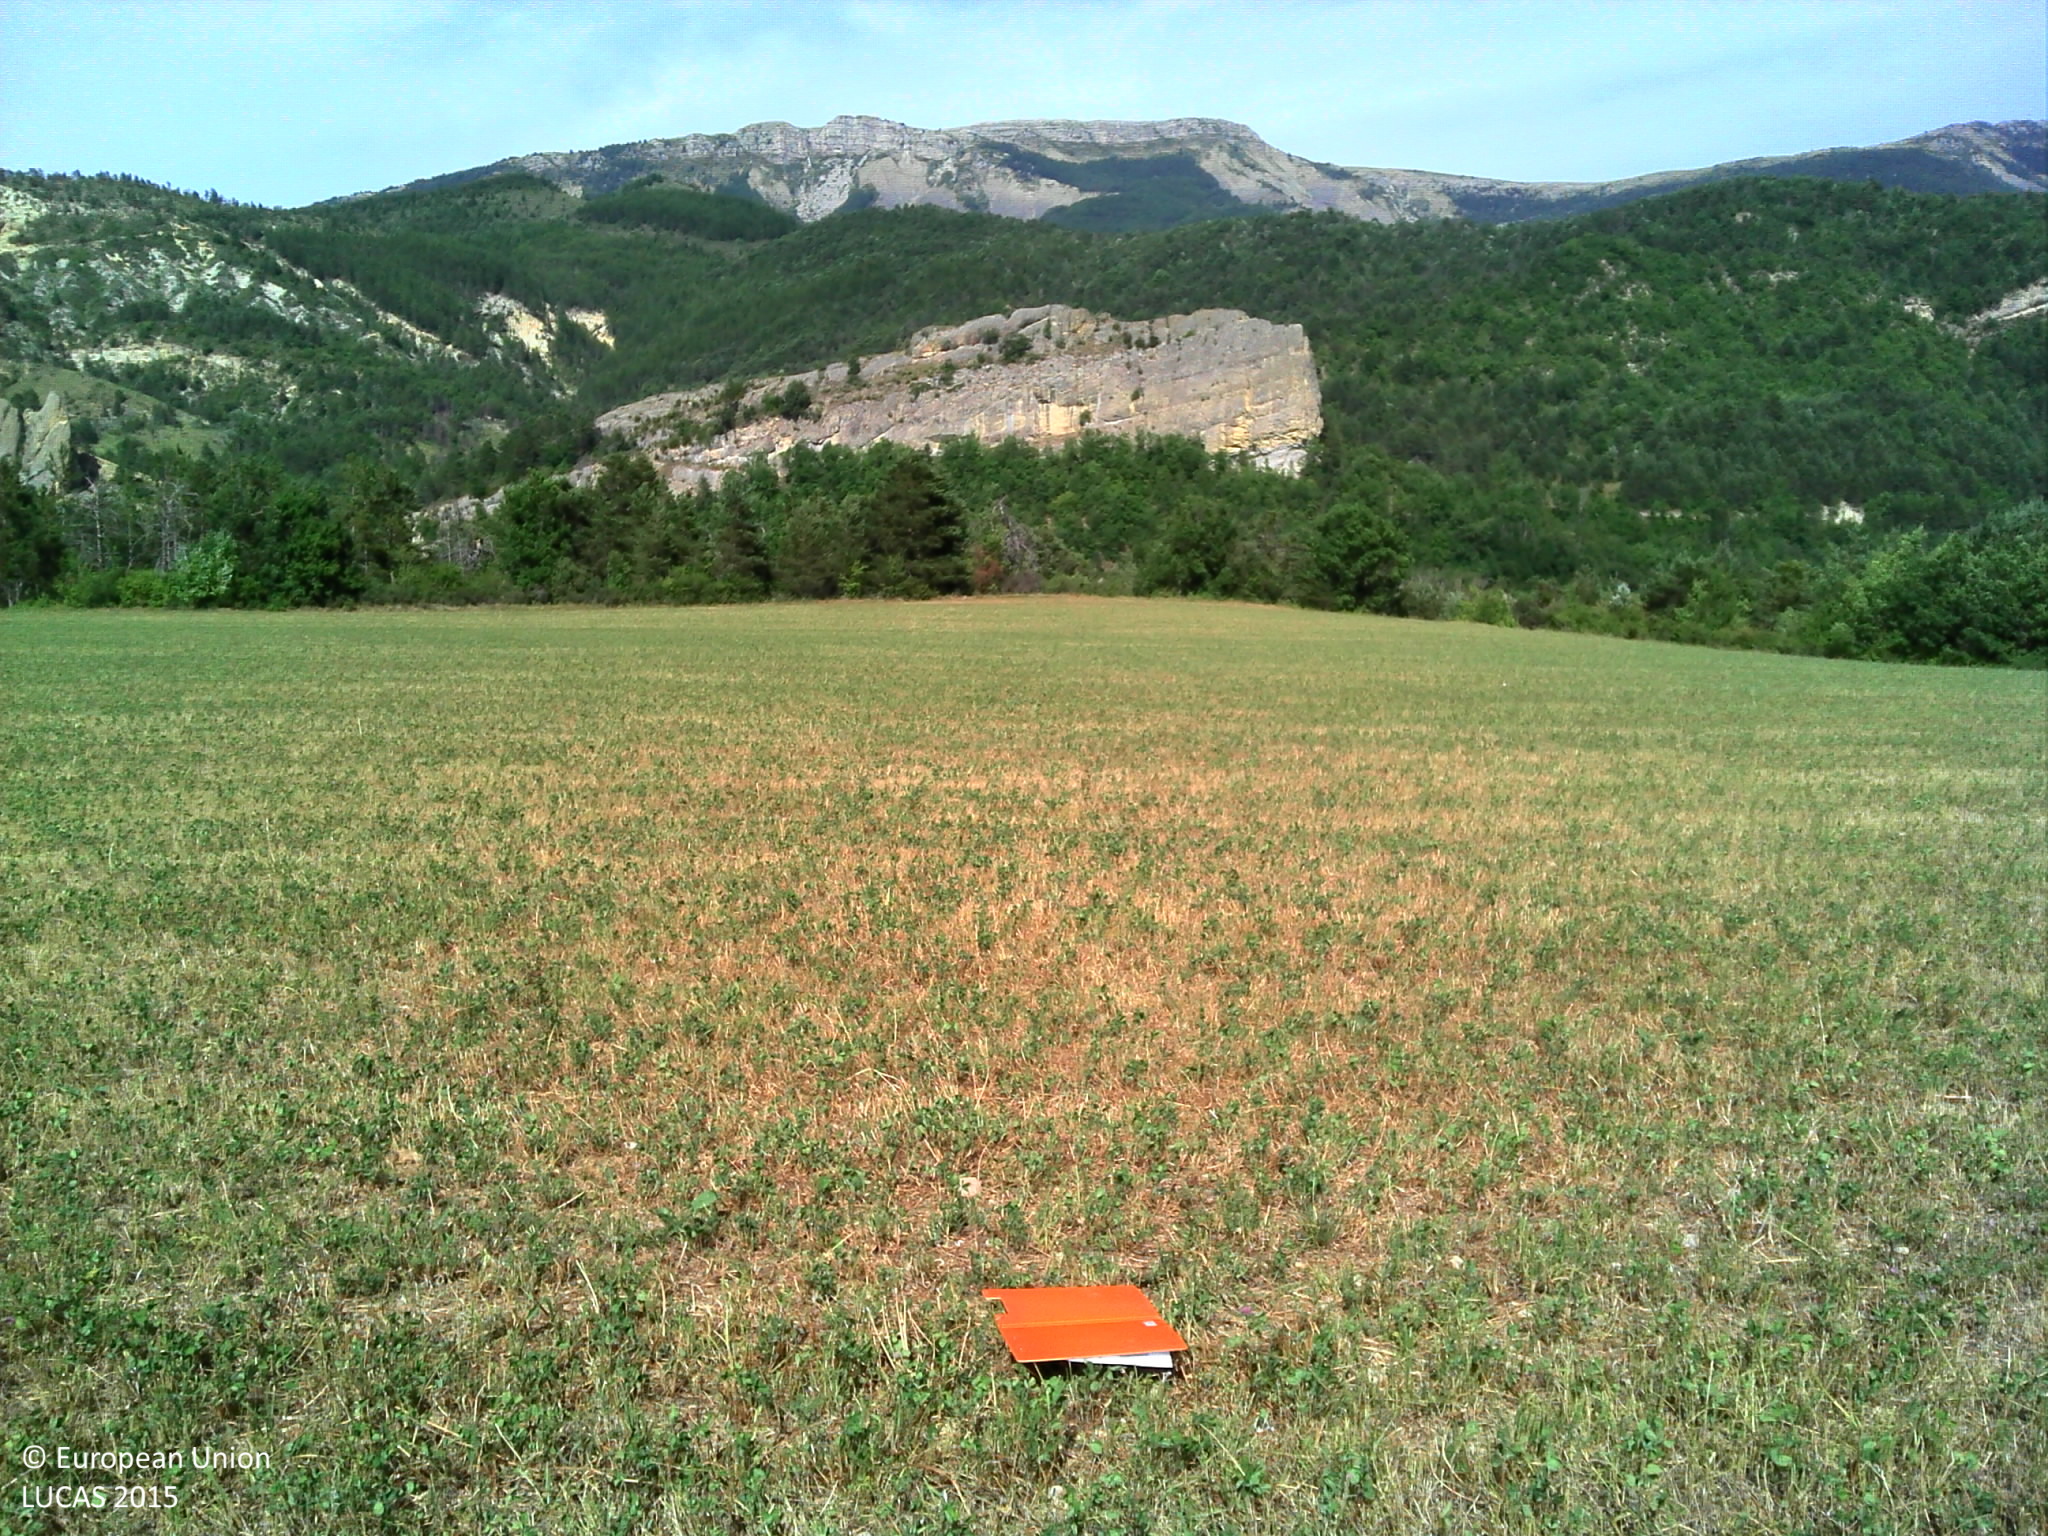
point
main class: Cropland
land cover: Temporary grasslands
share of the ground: > 75 %
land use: Agriculture (excluding fallow land and kitchen gardens)
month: July
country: FR
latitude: 43.9093
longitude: 6.4091
